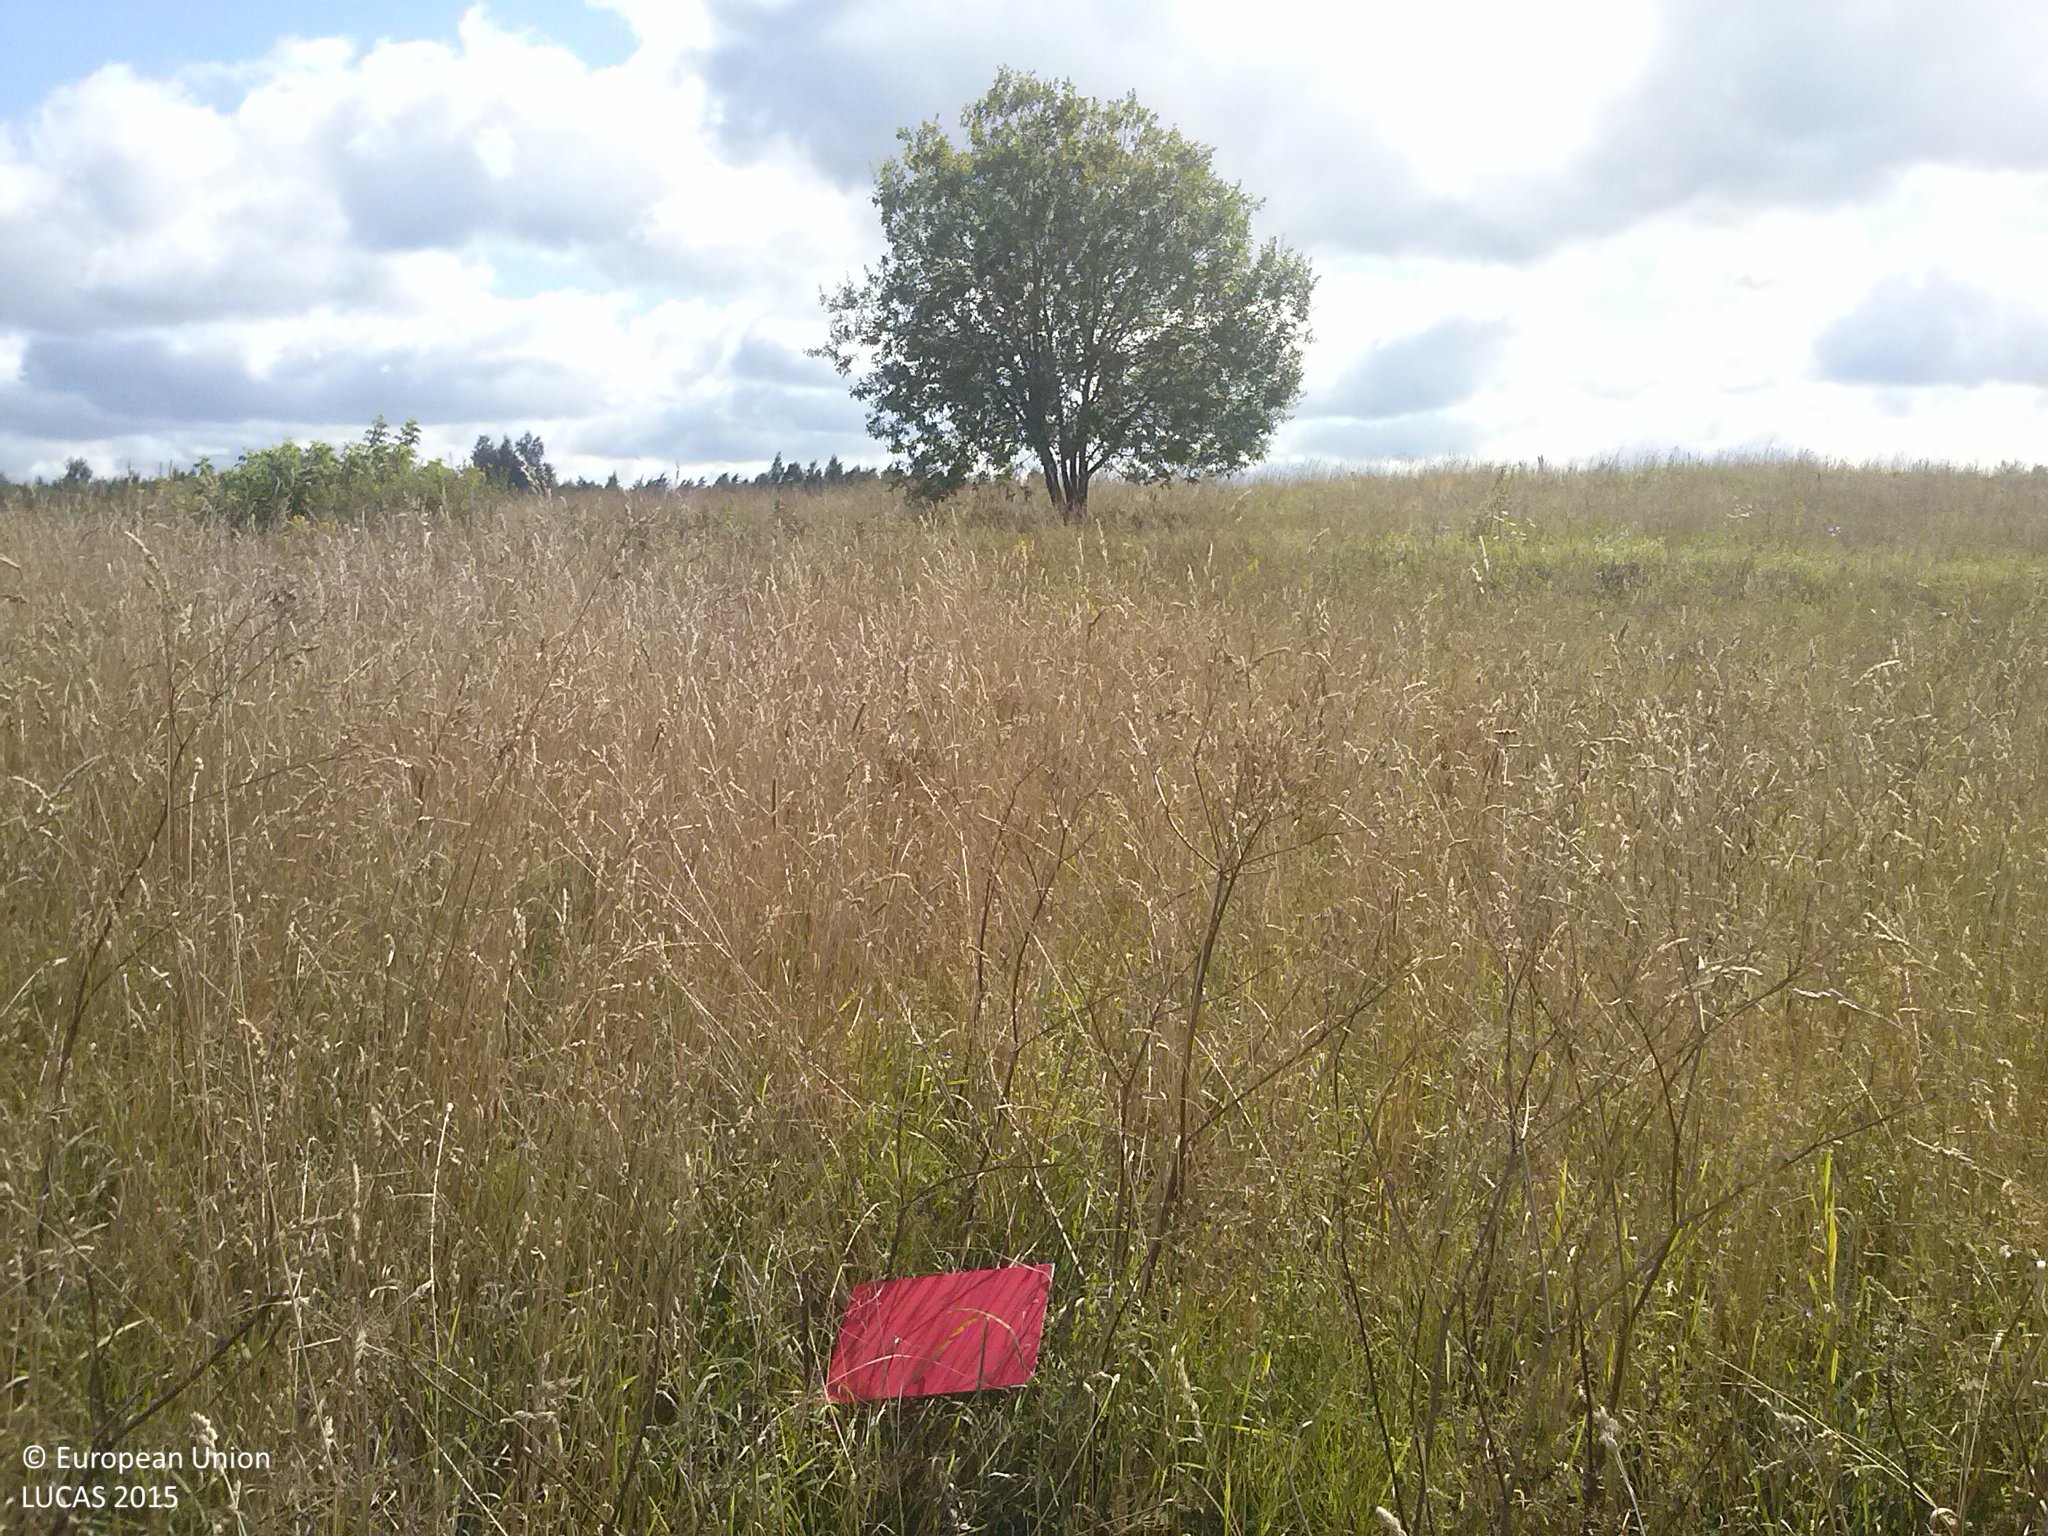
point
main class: Grassland
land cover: Grassland without tree/shrub cover
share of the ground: > 75 %
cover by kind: herbaceous plants 100 %
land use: Agriculture (excluding fallow land and kitchen gardens)
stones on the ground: < 10 %
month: August
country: LV
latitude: 56.1344
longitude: 26.8129
